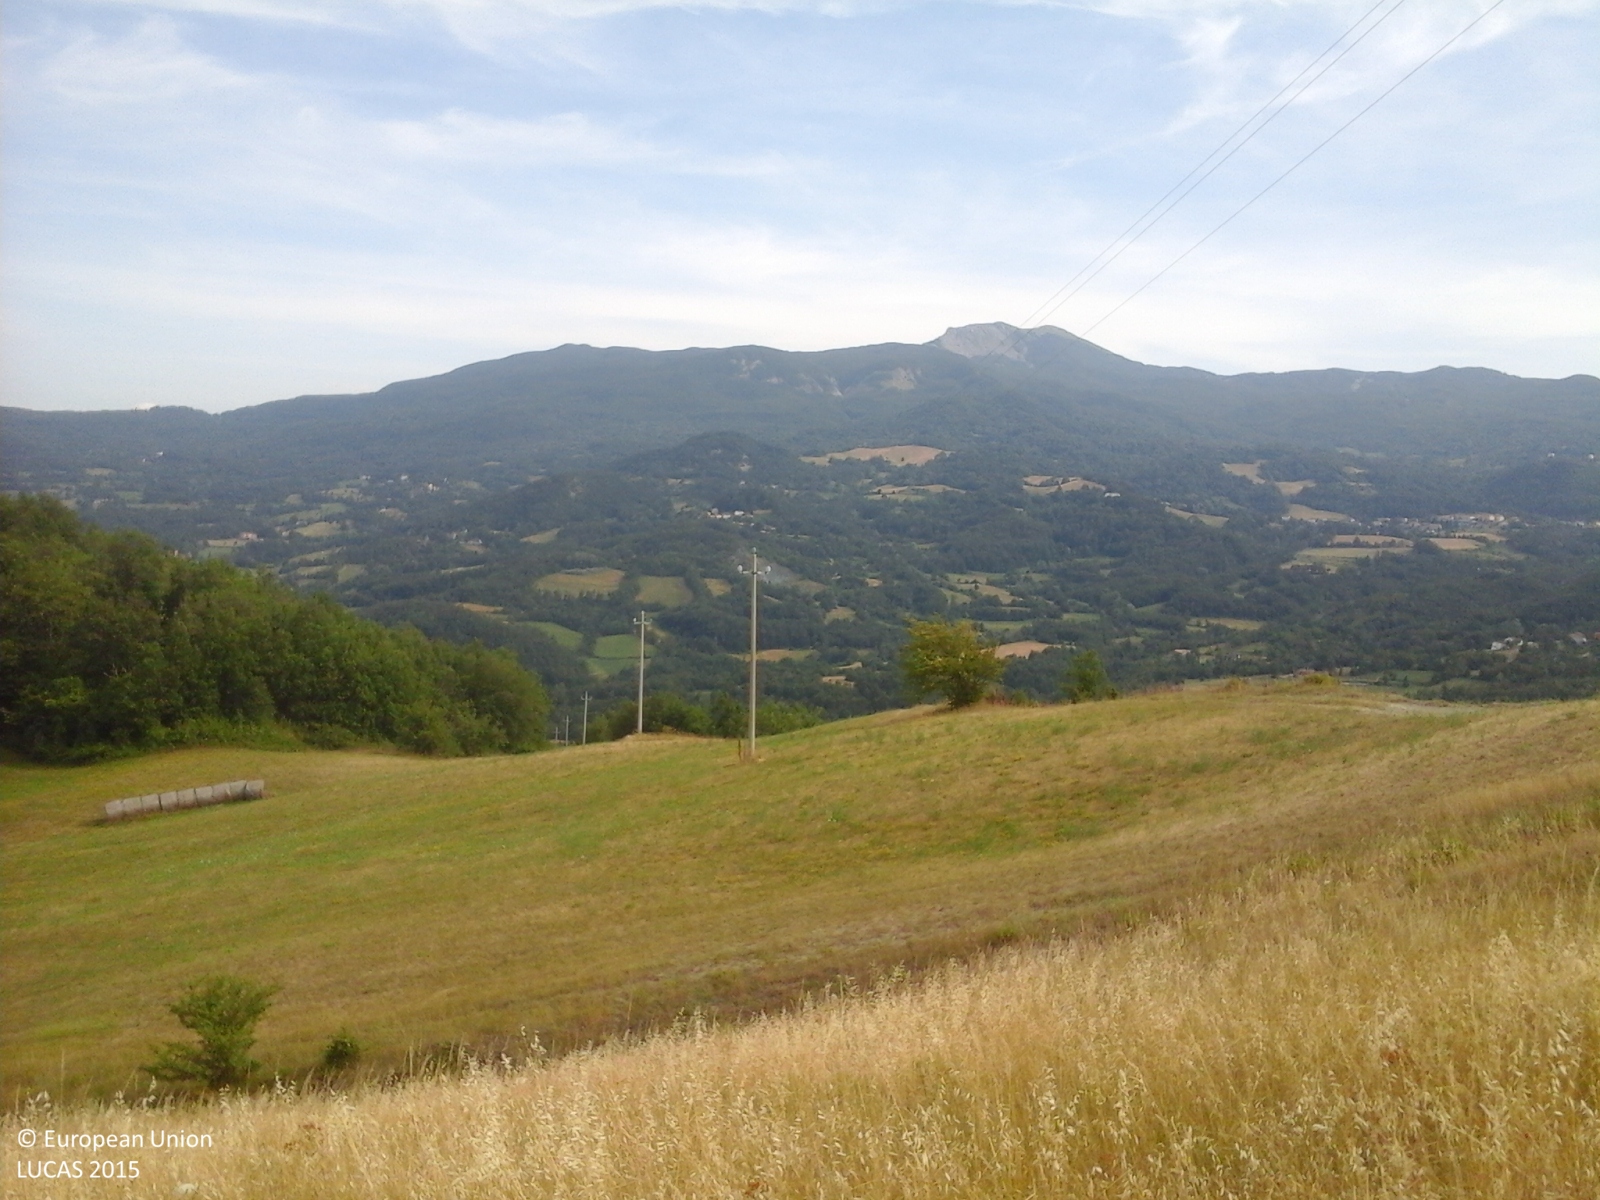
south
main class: Grassland
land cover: Grassland with sparse tree/shrub cover
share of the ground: > 75 %
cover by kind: herbaceous plants 90 %, broadleaved forest trees 5 %, shrubs 5 %
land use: Agriculture (excluding fallow land and kitchen gardens)
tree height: < 5 m
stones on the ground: 10 - 25 %
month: July
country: IT
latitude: 44.4403
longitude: 10.2883
